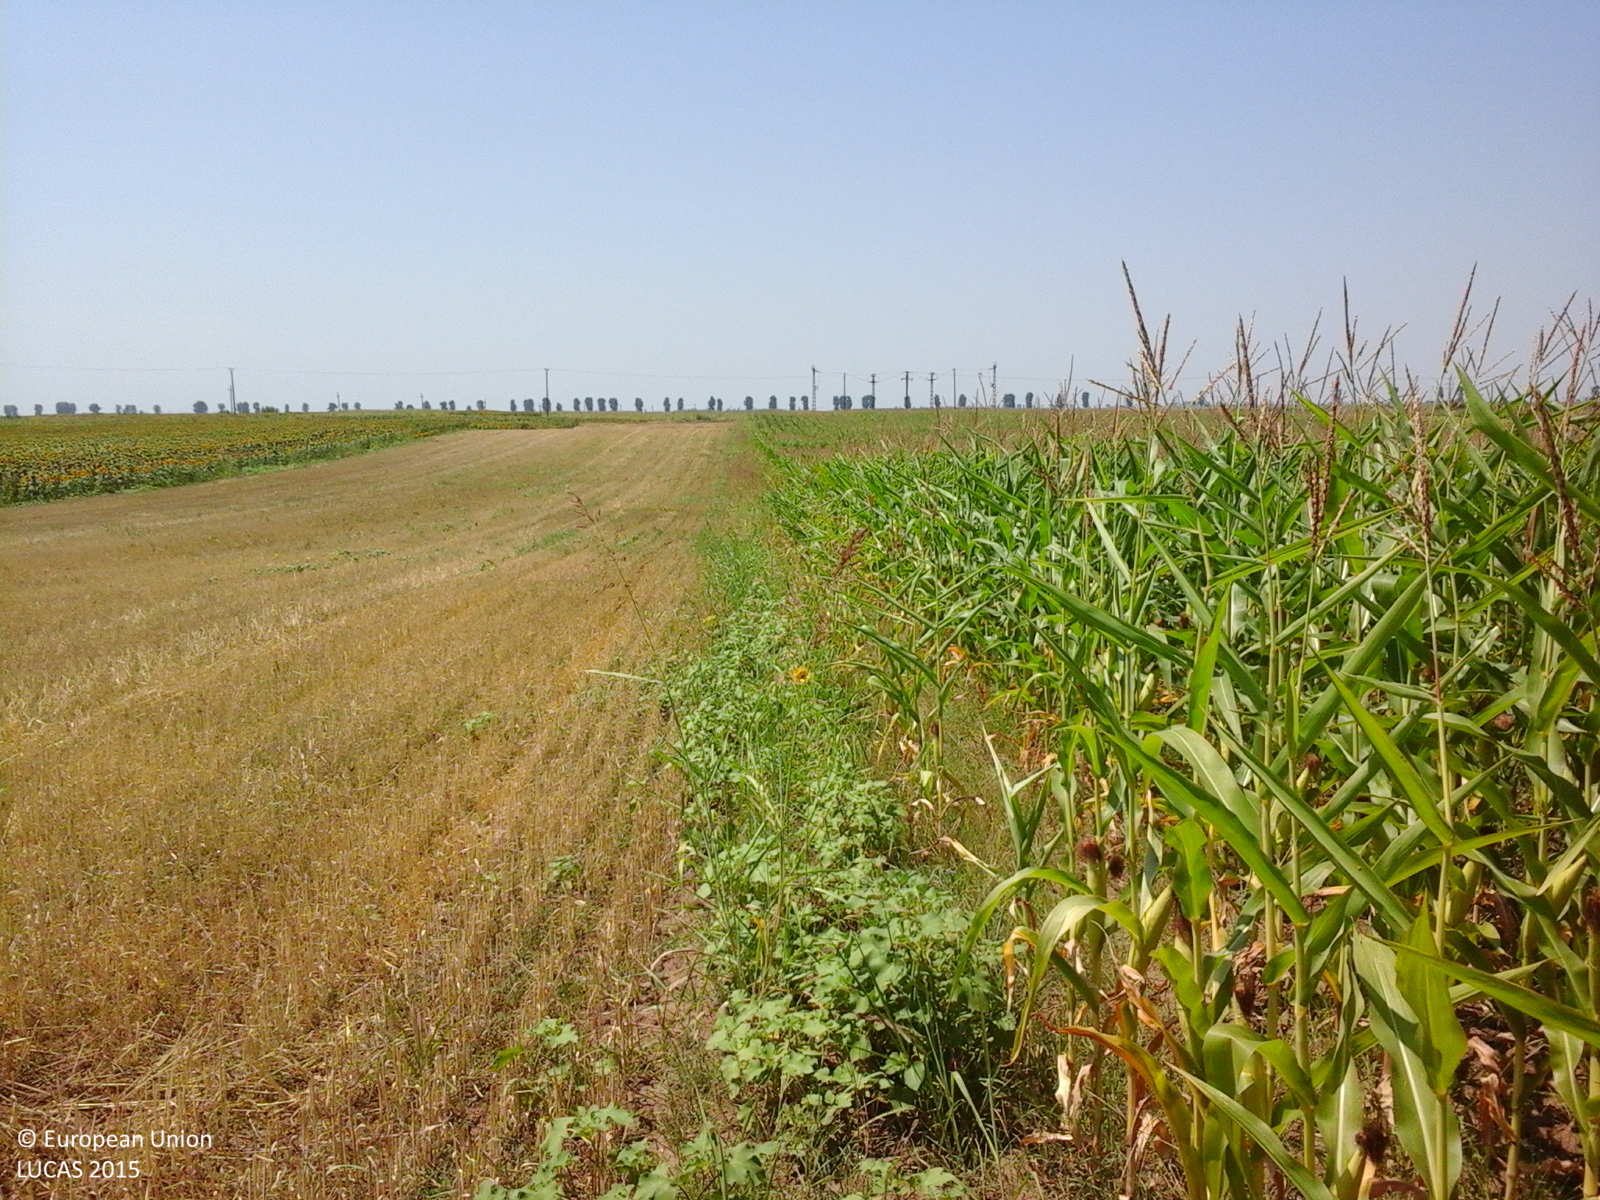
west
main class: Cropland
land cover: Maize
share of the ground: > 75 %
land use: Agriculture (excluding fallow land and kitchen gardens)
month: July
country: RO
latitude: 44.9003
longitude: 27.3533
